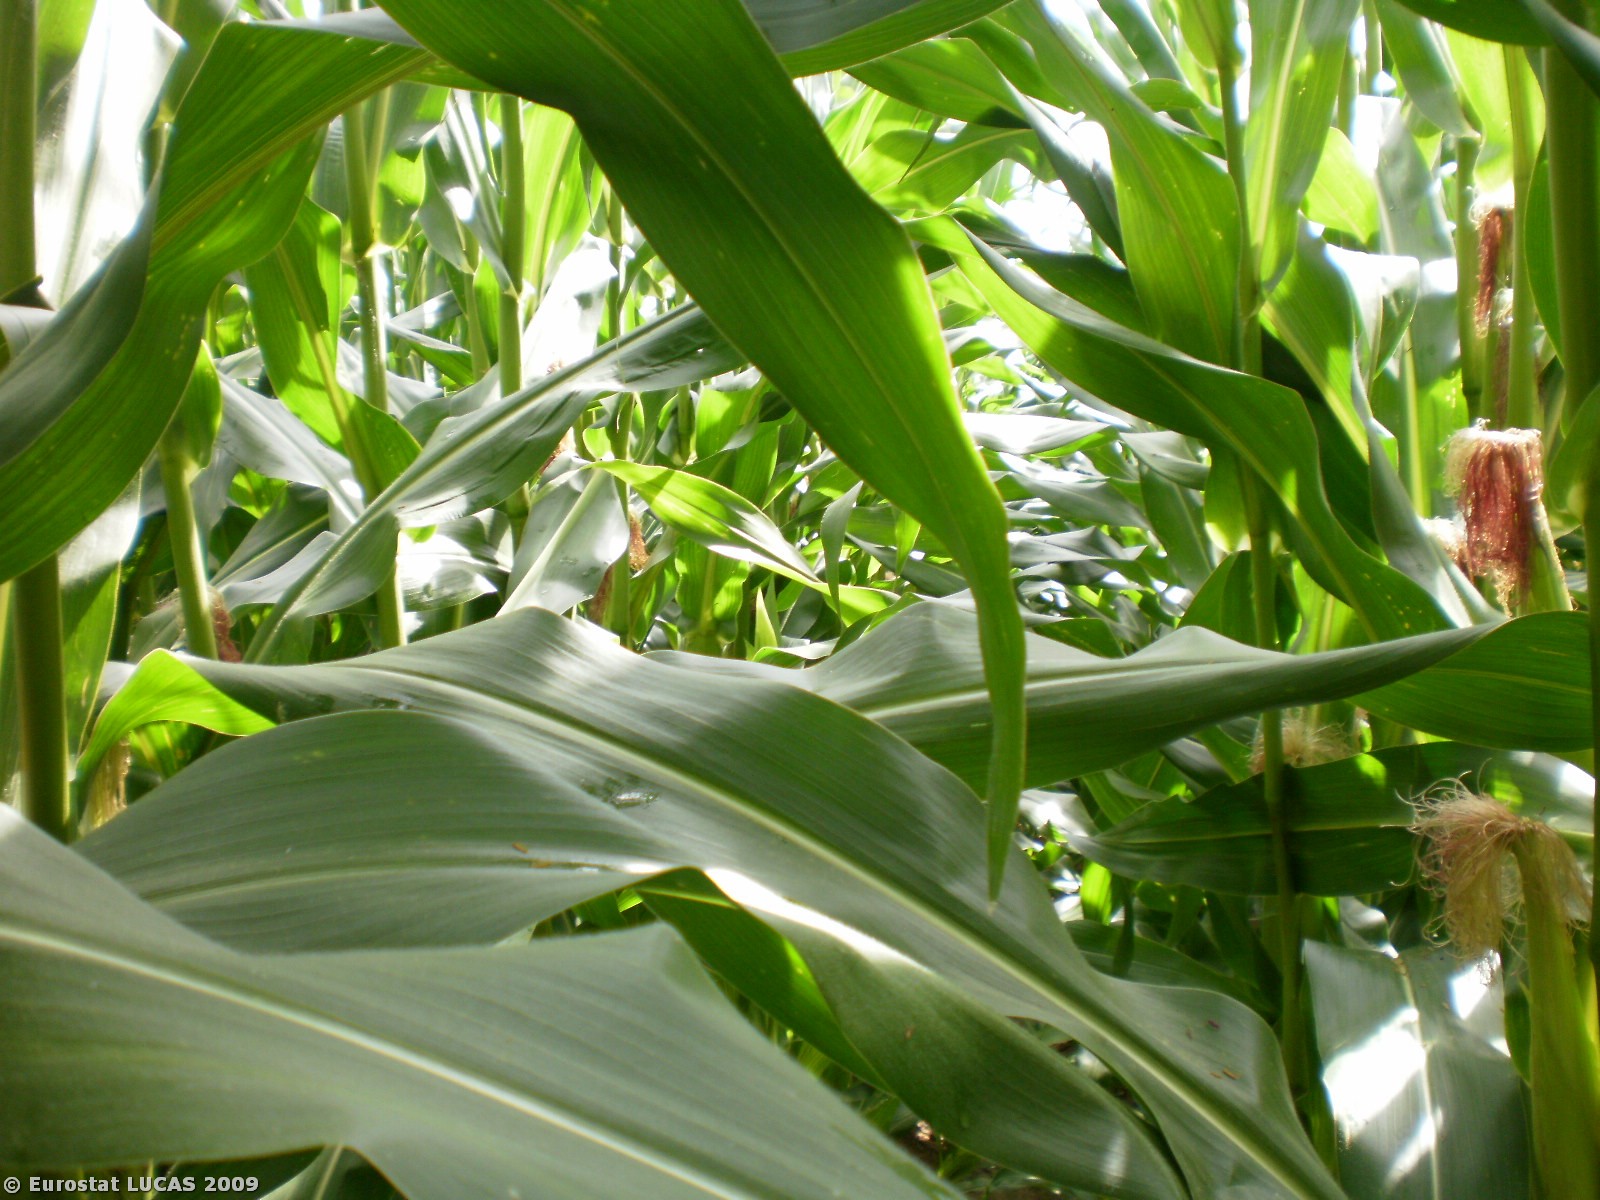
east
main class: Cropland
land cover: Maize
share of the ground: > 75 %
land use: Agriculture (excluding fallow land and kitchen gardens)
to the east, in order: Maize; Broadleaved woodland; Ditches and canals; Broadleaved woodland; Fences; Grassland without tree/shrub cover; Broadleaved woodland; Grassland without tree/shrub cover
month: July
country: BE
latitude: 50.7885
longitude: 2.8255
